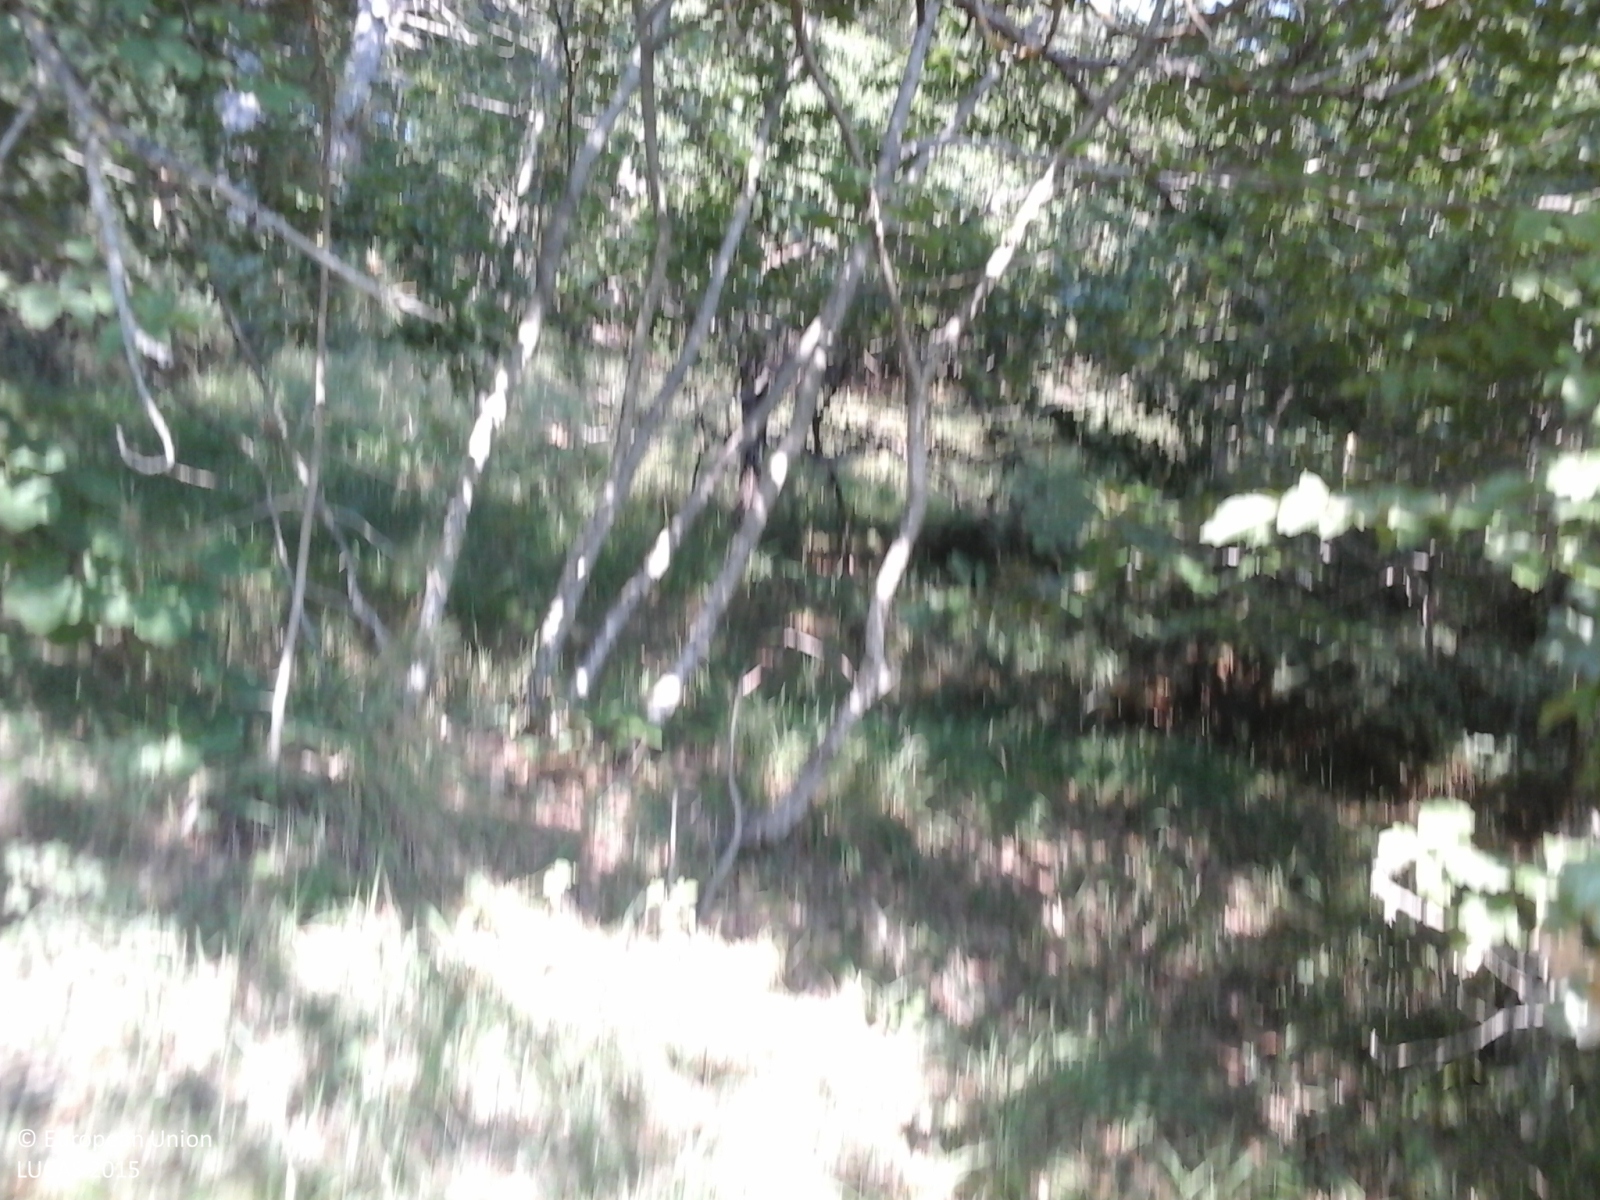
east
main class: Woodland
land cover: Pine dominated mixed woodland
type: coniferous forest of the mediterranean region
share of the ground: > 75 %
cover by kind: coniferous forest trees 75 %, broadleaved forest trees 25 %
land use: Forestry
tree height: > 5 m
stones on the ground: < 10 %
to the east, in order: Pine dominated mixed woodland; Pine dominated coniferous woodland; Grass margins; Paved roads, cycling and walking lanes; Grass margins; Pine dominated coniferous woodland; Grass margins; Paved roads, cycling and walking lanes; Shruby margins; Pine dominated coniferous woodland
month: August
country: IT
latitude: 42.9118
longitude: 13.1634
